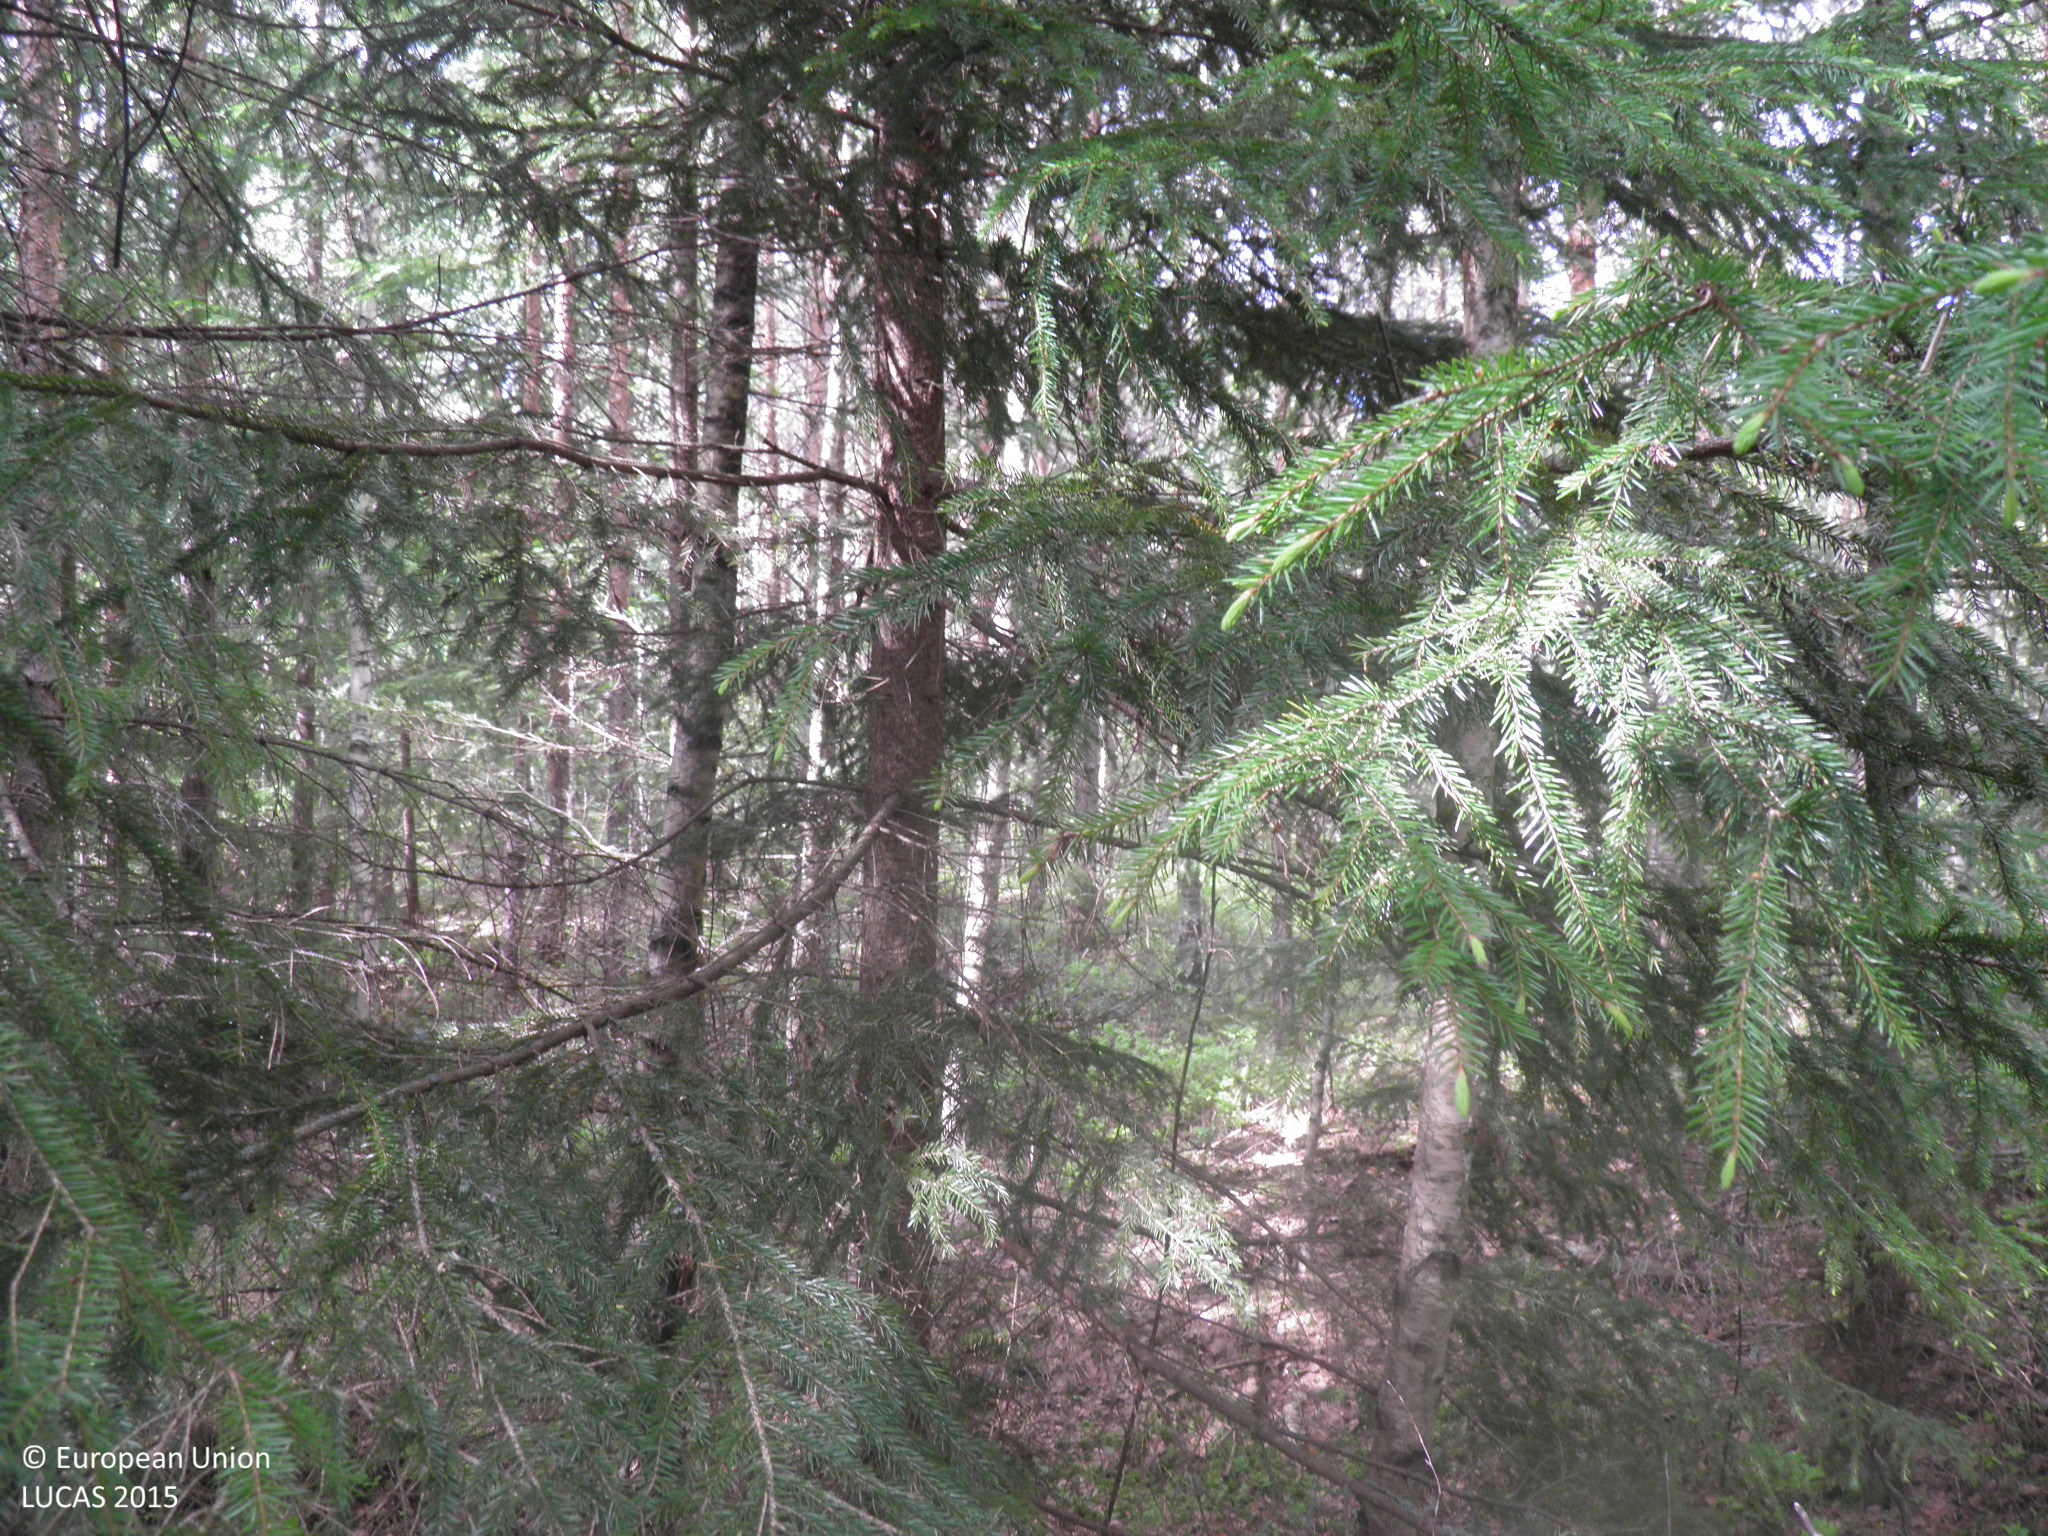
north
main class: Woodland
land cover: Other coniferous woodland
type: boreal forest
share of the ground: > 75 %
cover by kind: coniferous forest trees 70 %, broadleaved forest trees 20 %, shrubs 5 %, lichens and mosses 5 %
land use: Forestry
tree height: > 5 m
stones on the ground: < 10 %
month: June
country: FI
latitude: 60.5625
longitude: 22.6027
